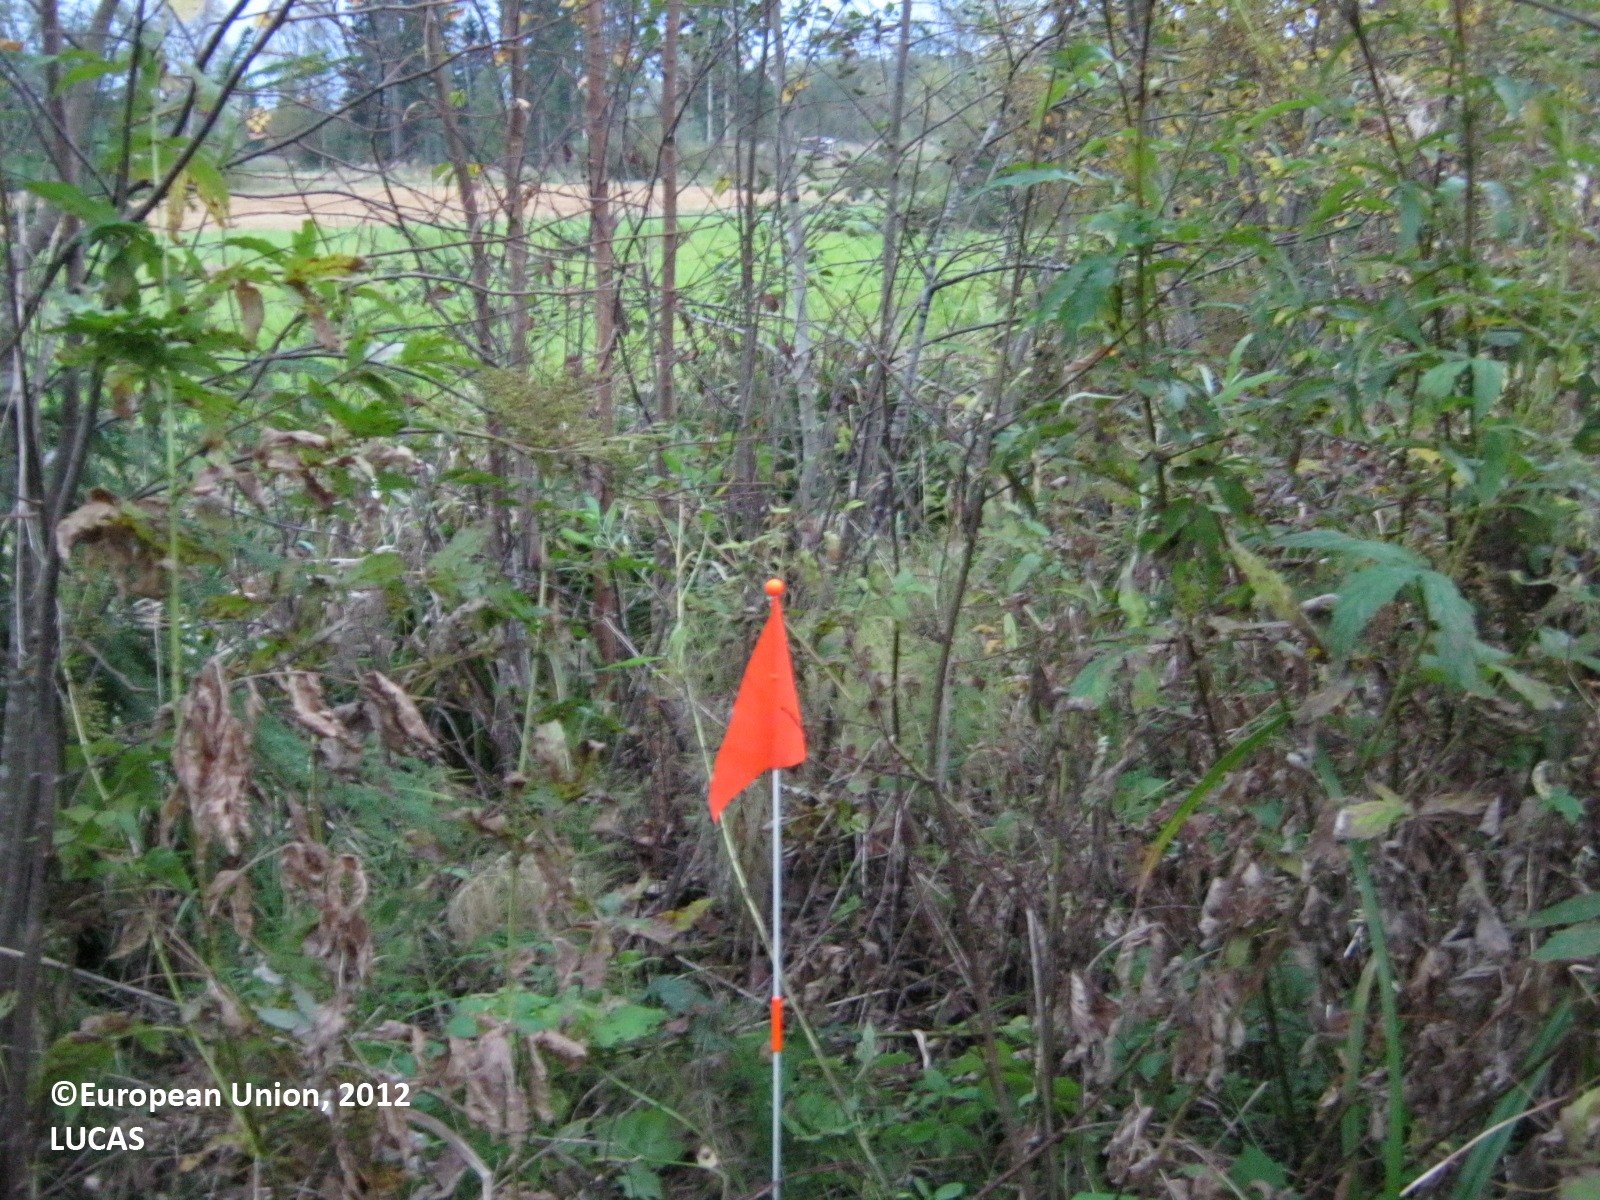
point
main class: Woodland
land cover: Broadleaved woodland
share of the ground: > 75 %
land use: Forestry
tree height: < 5 m
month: September
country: FI
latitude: 61.0083
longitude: 28.1639
